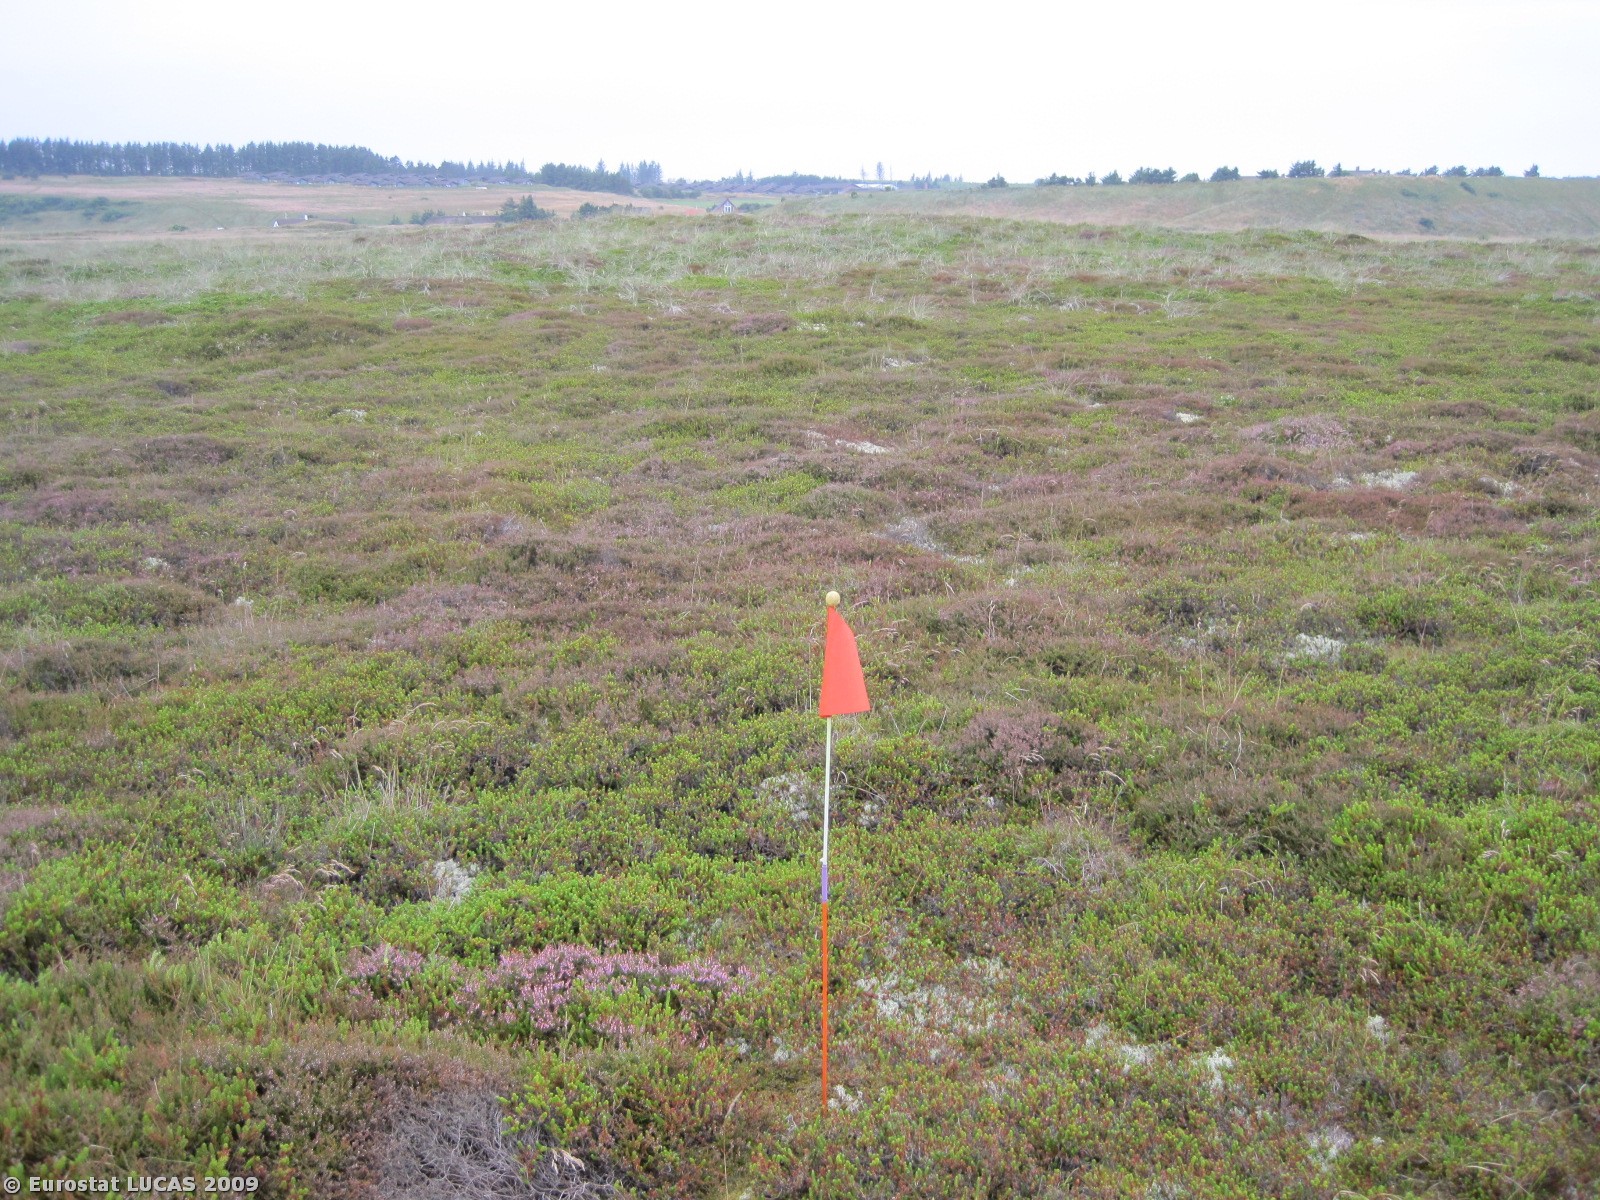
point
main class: Grassland
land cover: Grassland without tree/shrub cover
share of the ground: > 75 %
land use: Nature reserves
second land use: Amenities, museums, leisure
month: July
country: DK
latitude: 57.0984
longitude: 8.7309
